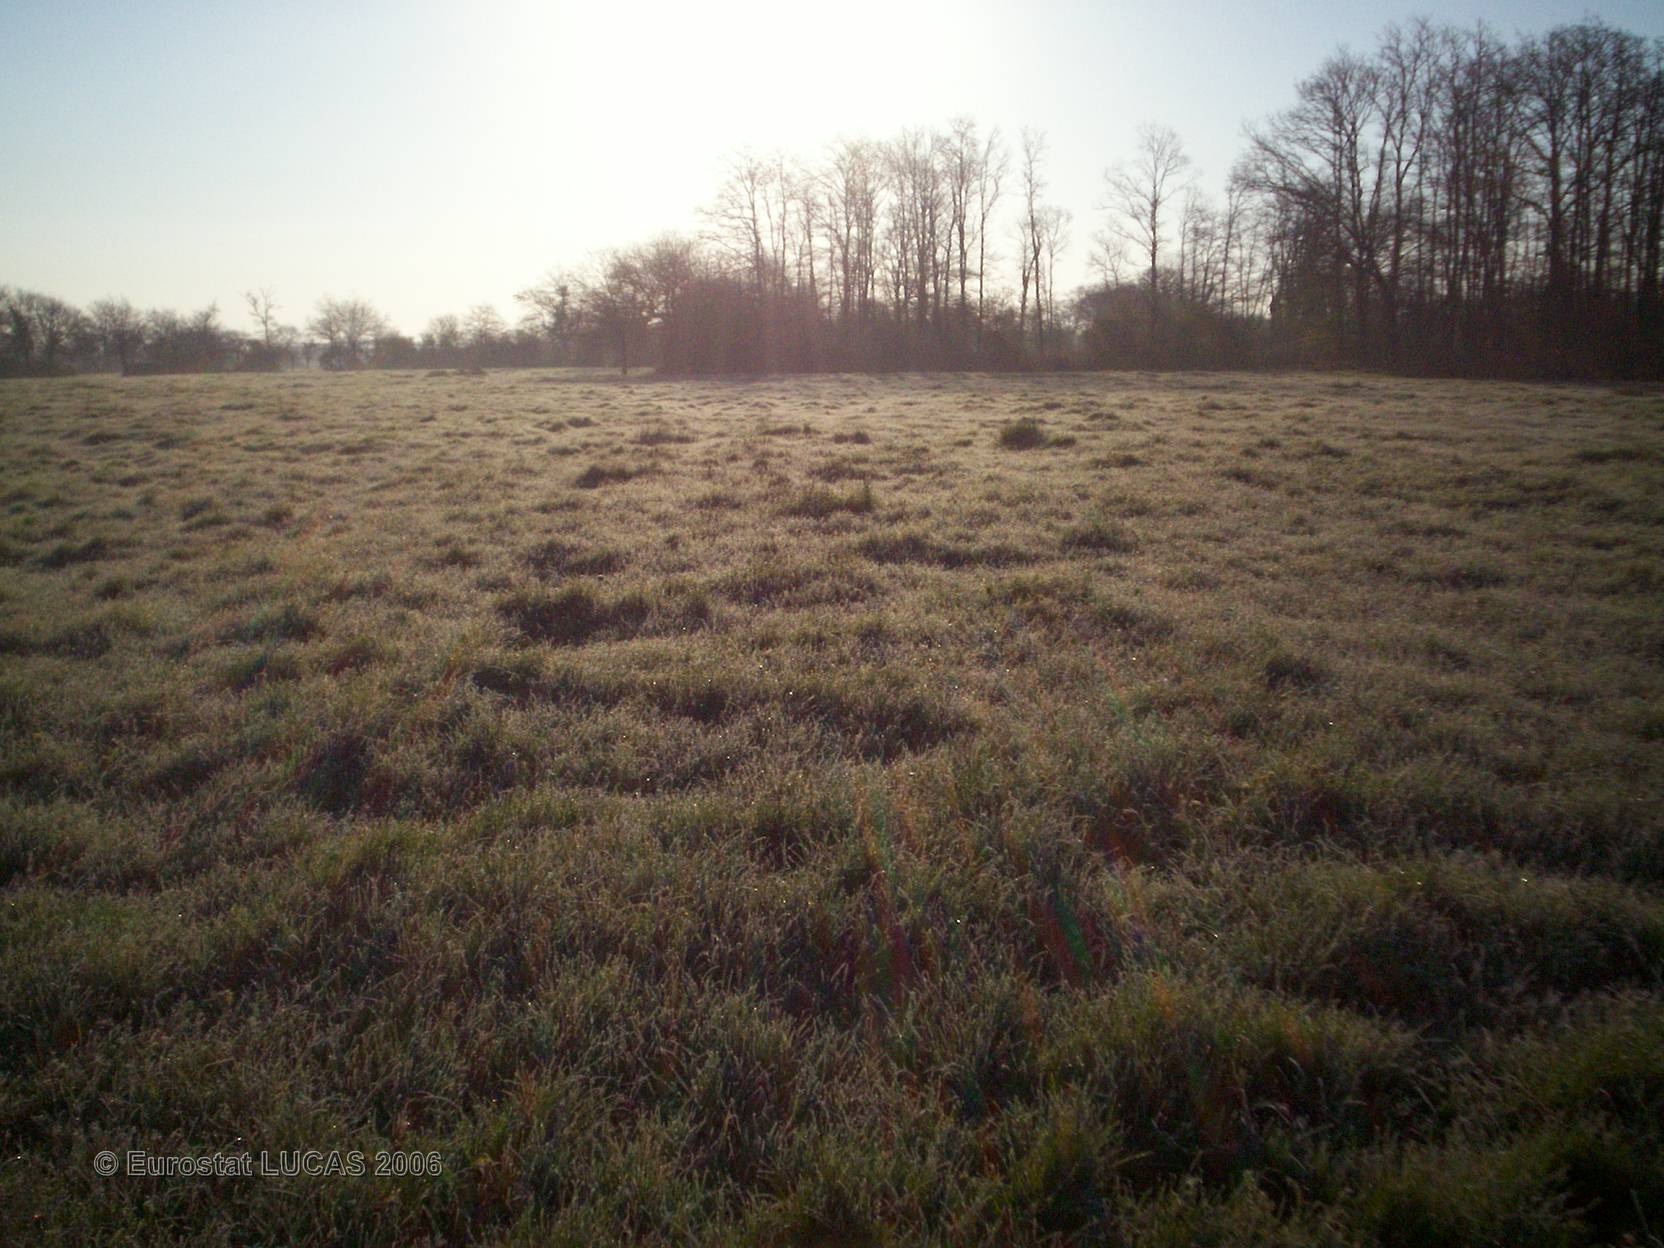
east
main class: Grassland
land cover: Grassland without tree/shrub cover
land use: Agriculture (excluding fallow land and kitchen gardens)
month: April
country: FR
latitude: 47.0418
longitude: -1.2910
